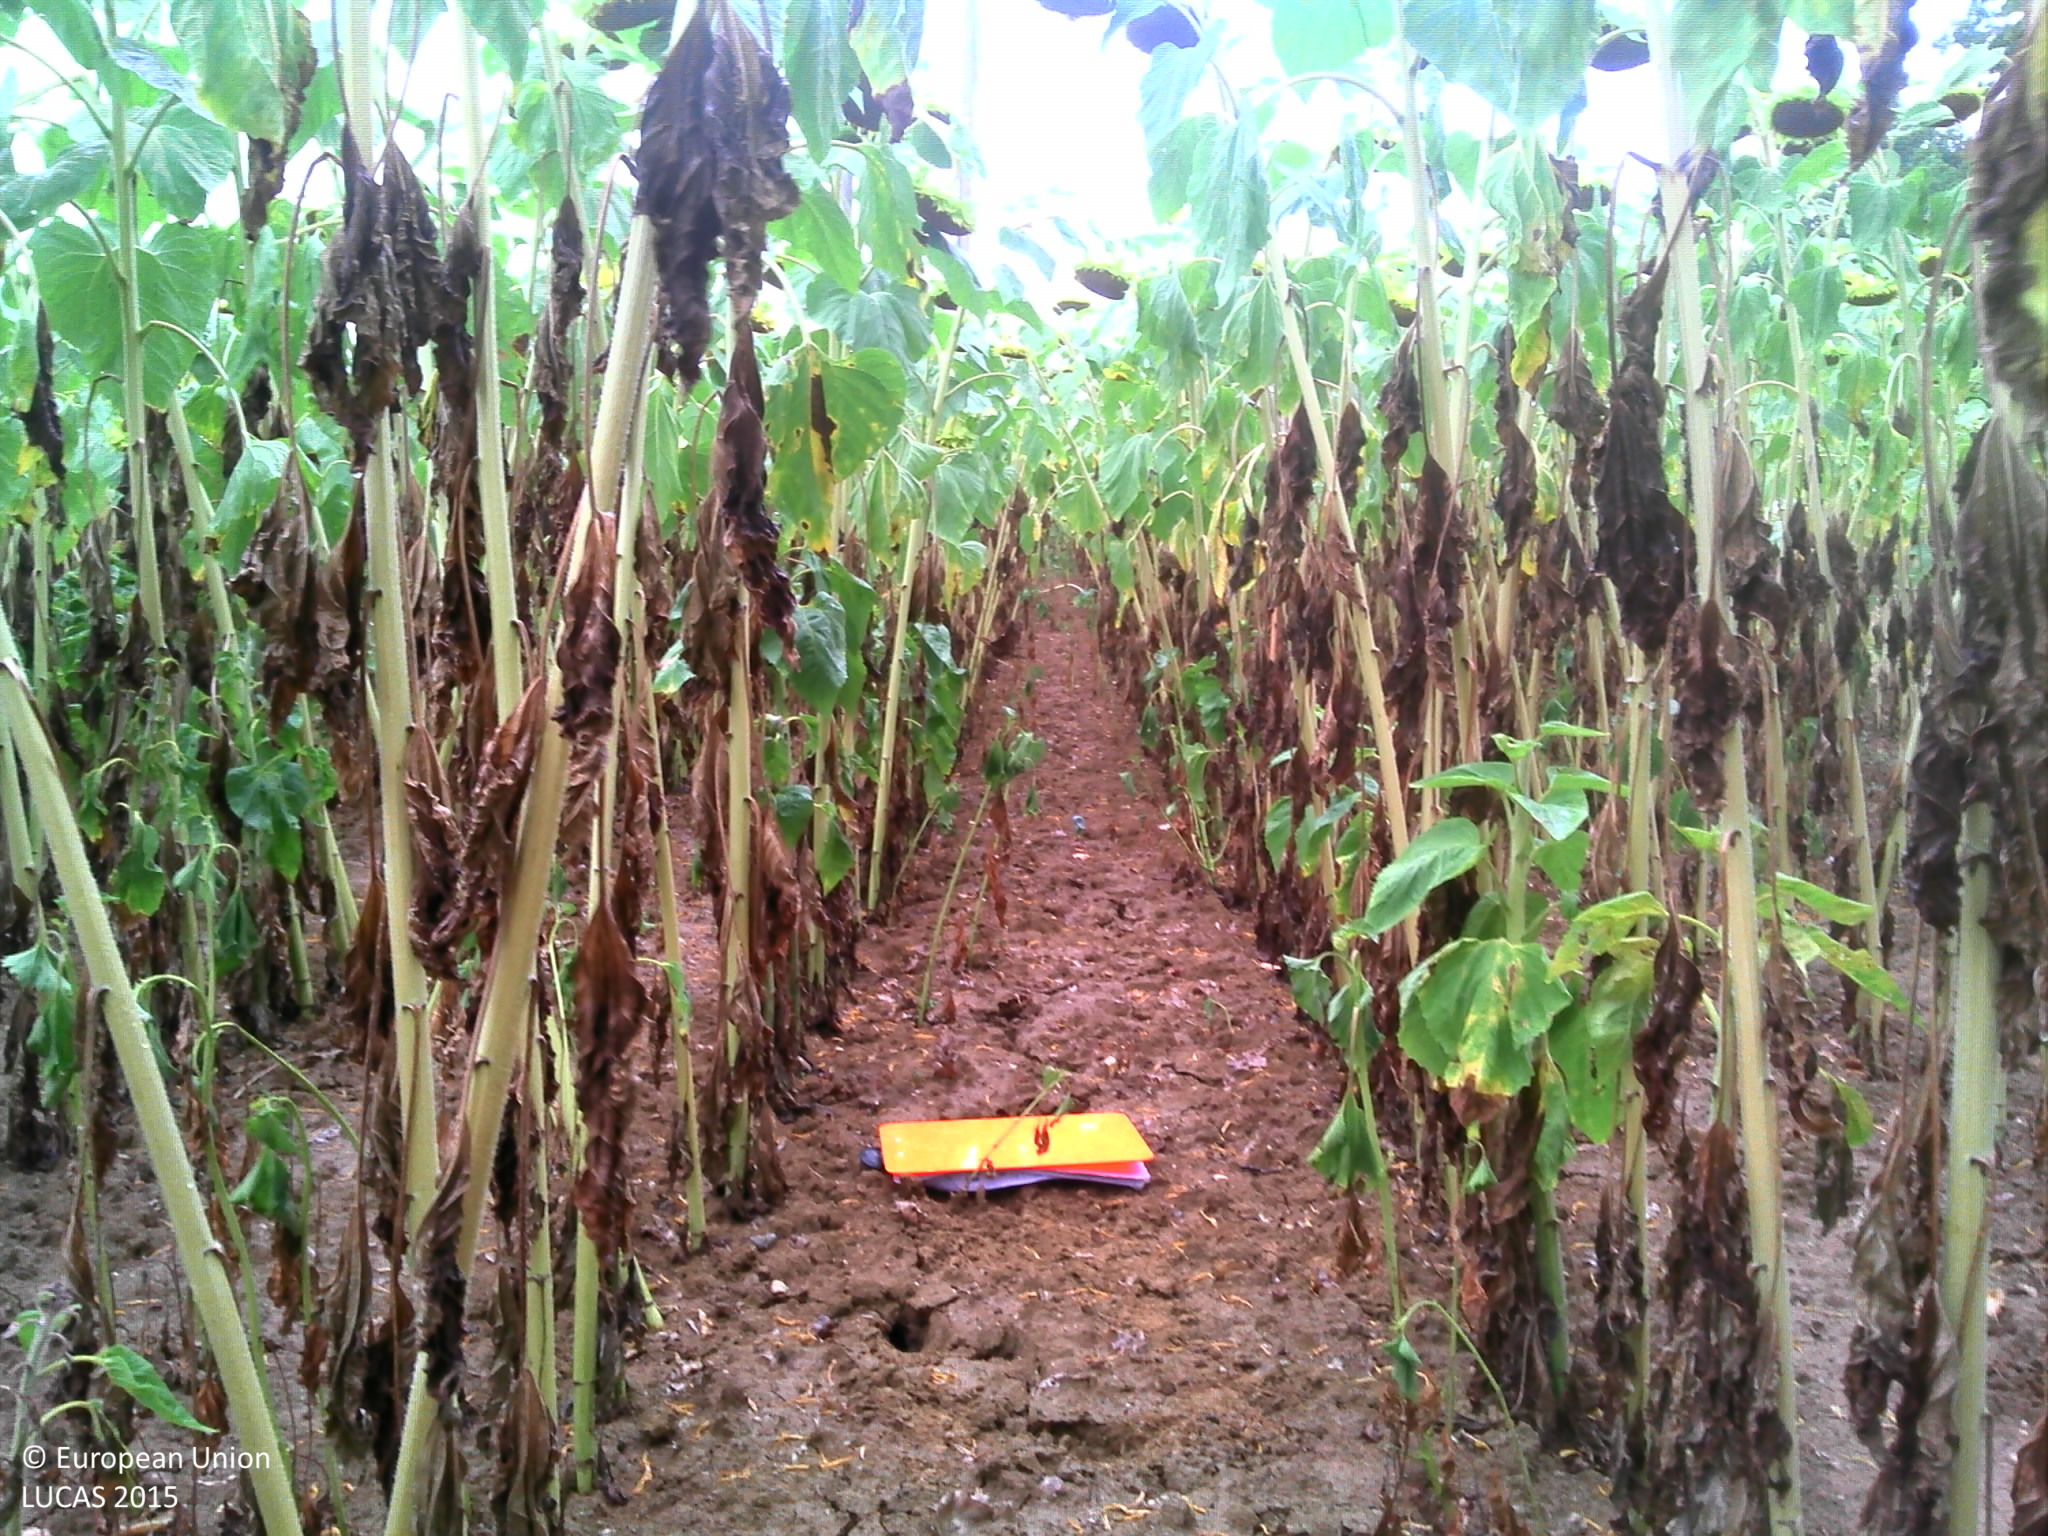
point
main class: Cropland
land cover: Sunflower
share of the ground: > 75 %
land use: Agriculture (excluding fallow land and kitchen gardens)
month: July
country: FR
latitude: 44.3828
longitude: 0.6679
